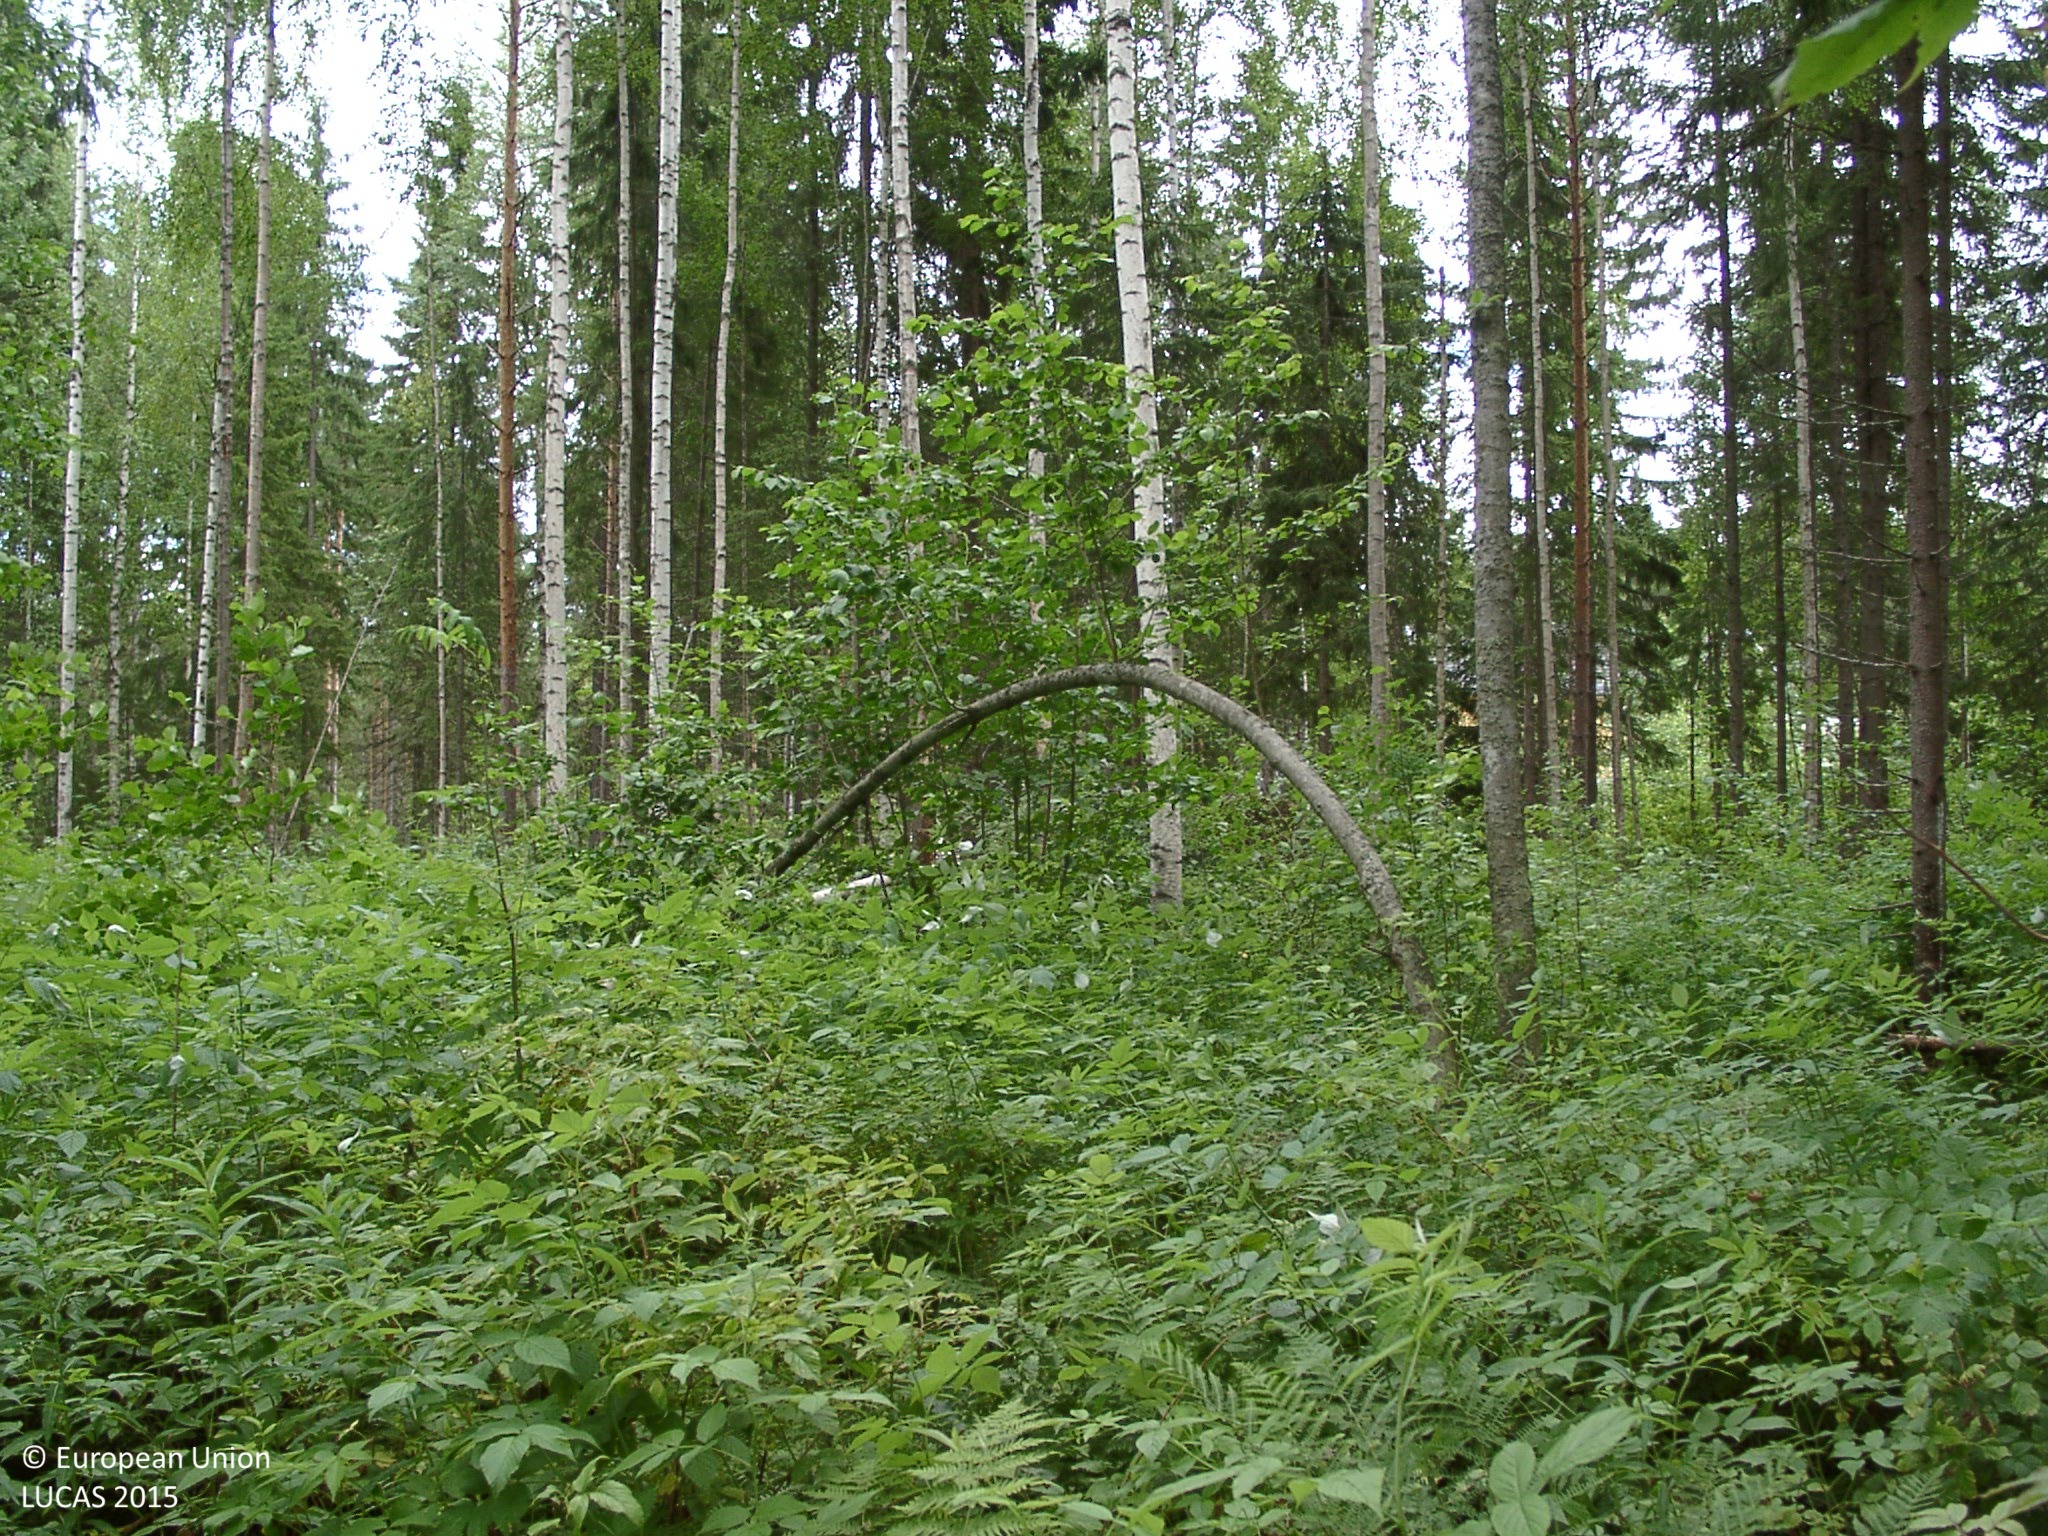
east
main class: Woodland
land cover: Spruce dominated mixed woodland
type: boreal forest
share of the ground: 50 - 75 %
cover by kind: coniferous forest trees 35 %, broadleaved forest trees 35 %, shrubs 15 %, herbaceous plants 15 %
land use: Forestry
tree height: > 5 m
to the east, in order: Spruce dominated mixed woodland; Ditches and canals; Spruce dominated mixed woodland; Artificial constructions in urban areas; Other coniferous woodland; Shruby margins; Other coniferous woodland; Other mixed woodland; Pine dominated mixed woodland
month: July
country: FI
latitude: 62.2594
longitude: 26.0541
